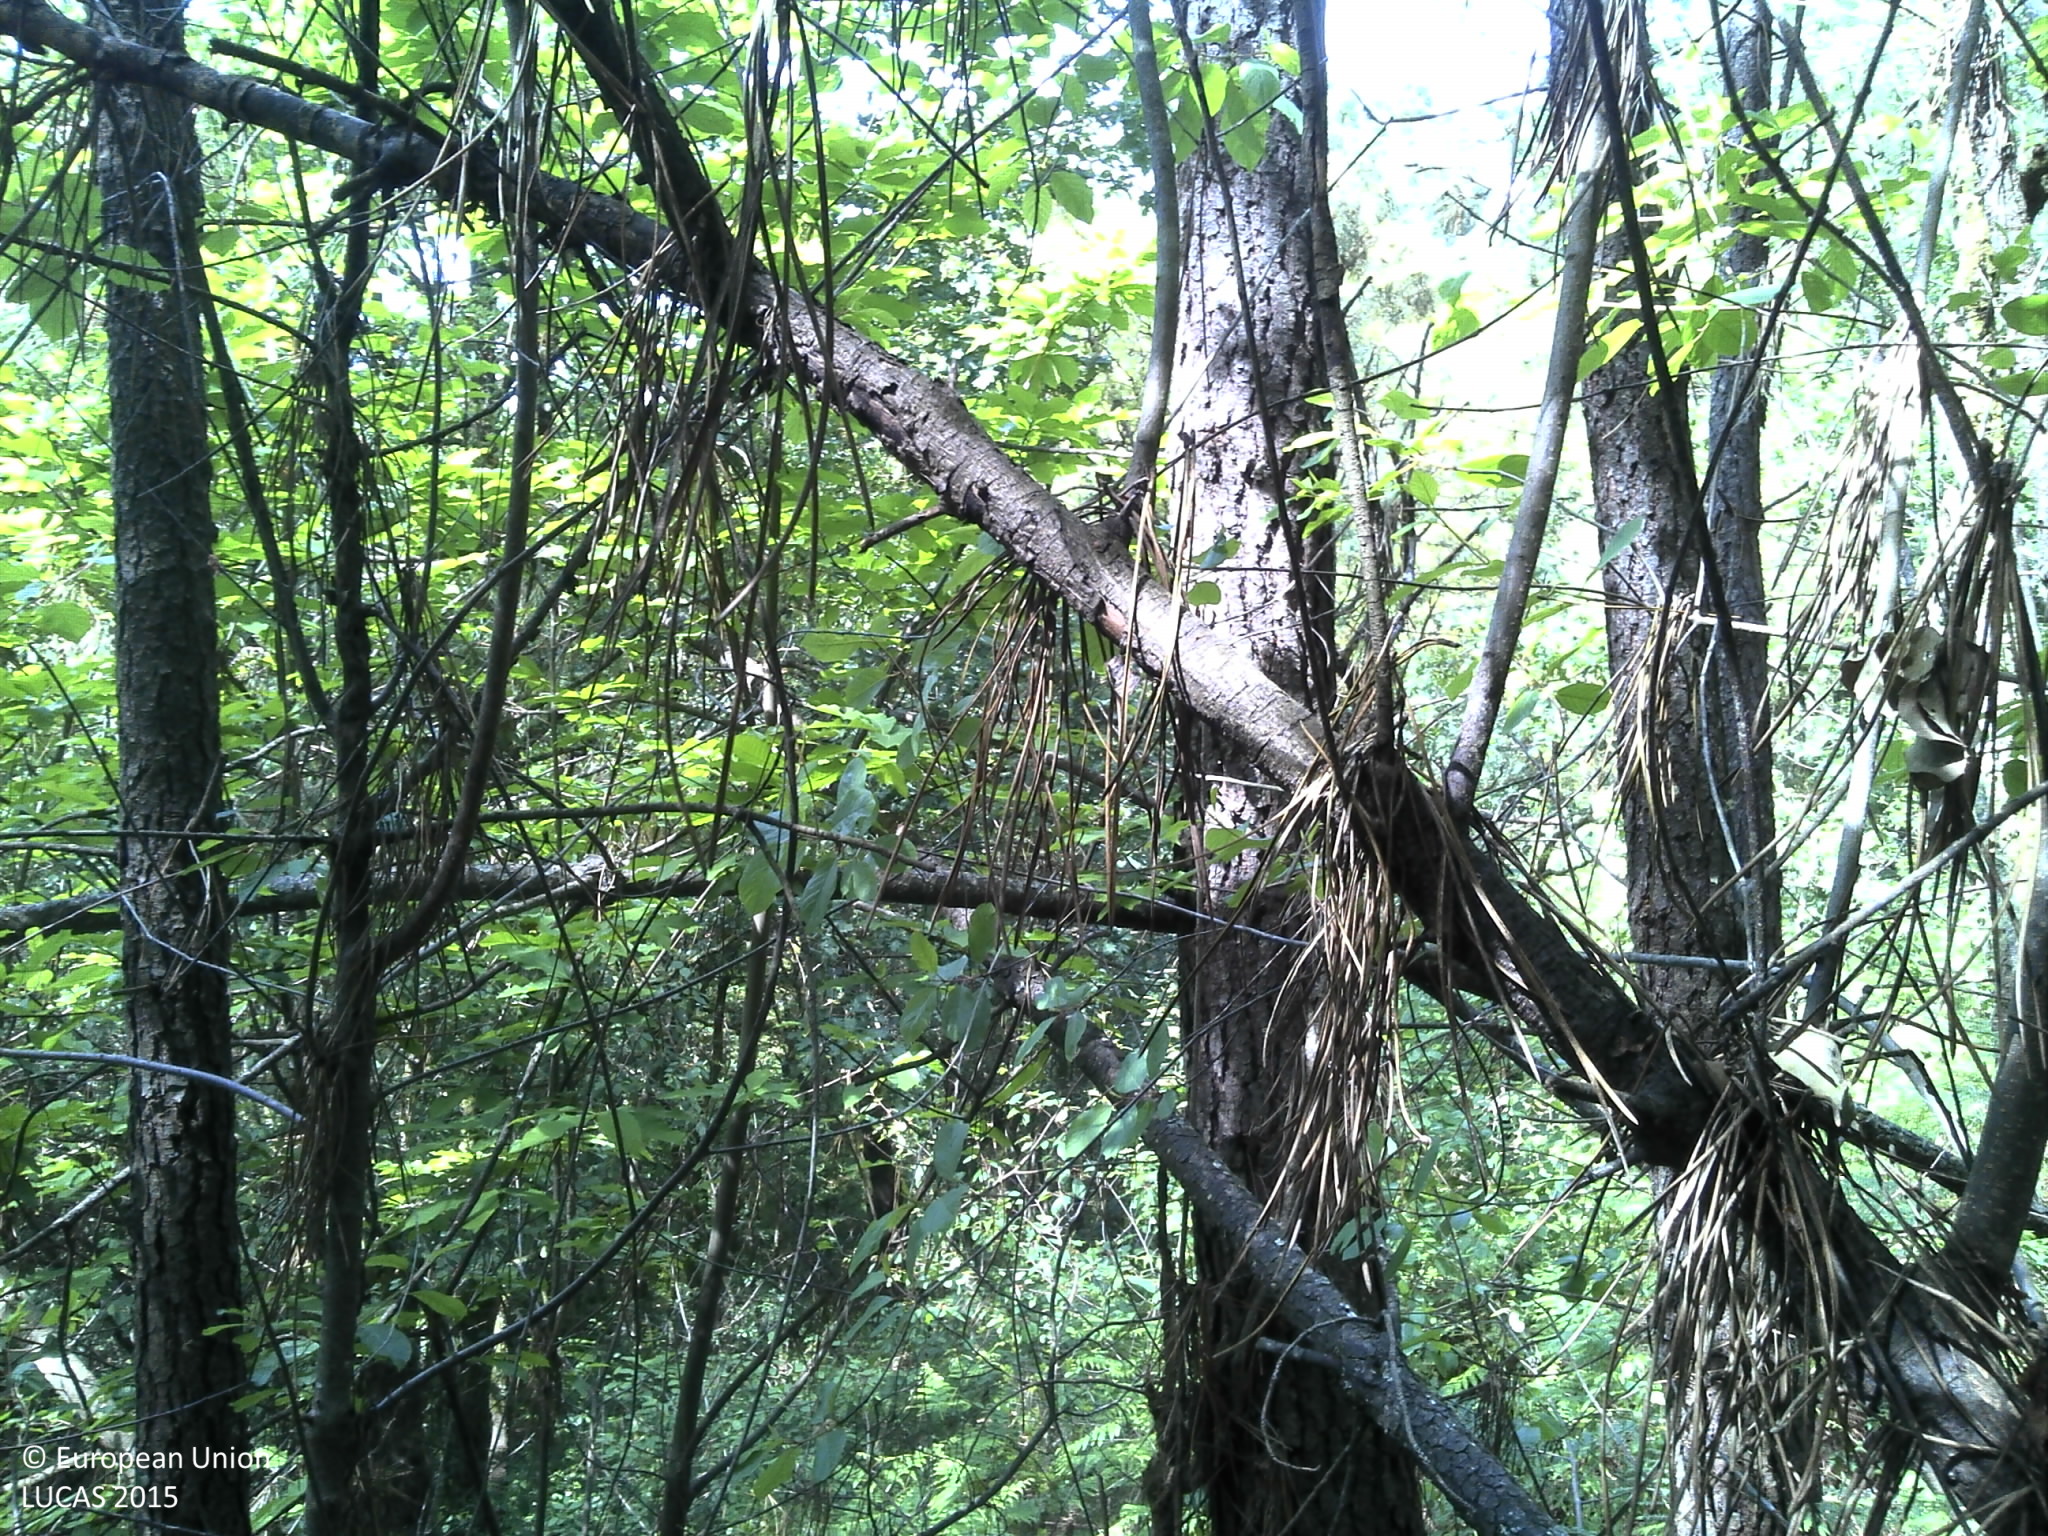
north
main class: Woodland
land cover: Broadleaved woodland
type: thermophilous deciduous forest
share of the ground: > 75 %
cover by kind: broadleaved forest trees 85 %, unconsolidated bare surface 10 %, shrubs 5 %
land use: Forestry
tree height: > 5 m
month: May
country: PT
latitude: 40.9069
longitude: -8.3400
